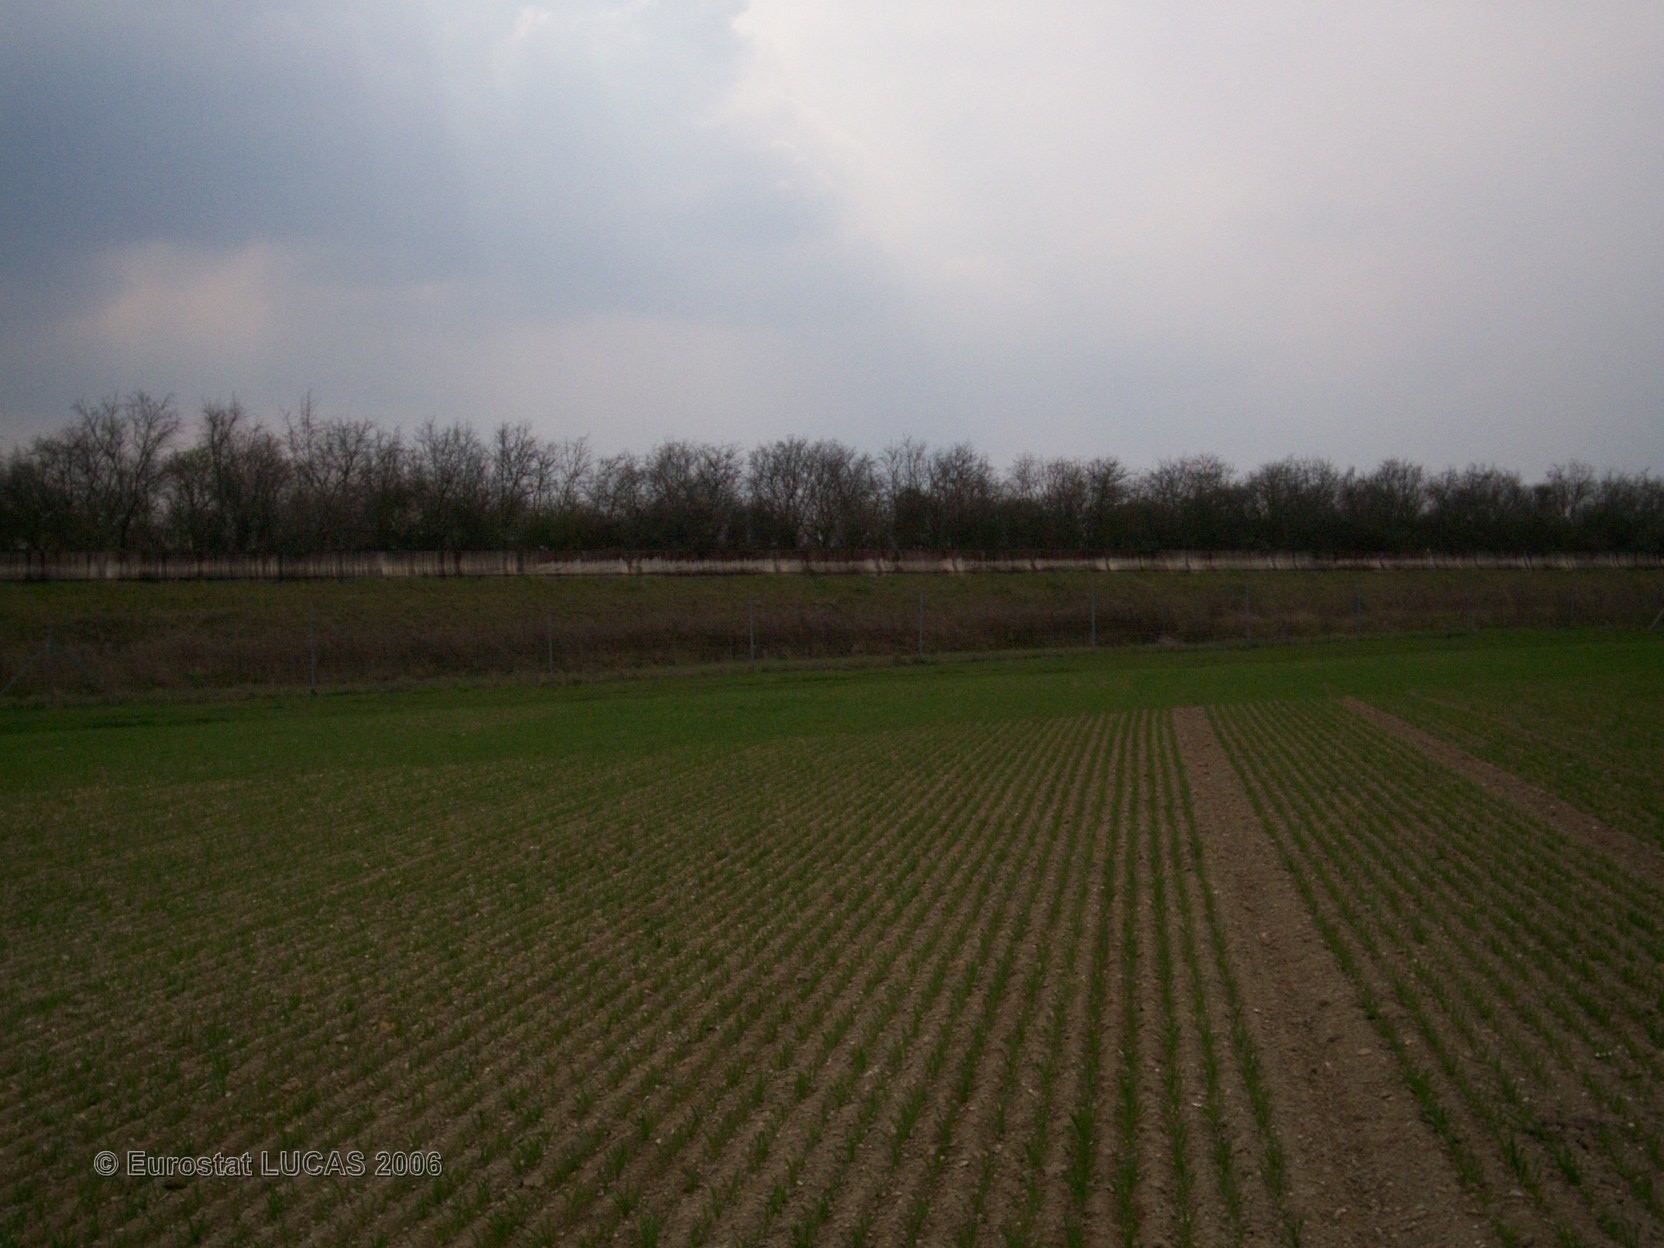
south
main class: Cropland
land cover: Barley
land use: Agriculture (excluding fallow land and kitchen gardens)
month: April
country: FR
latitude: 48.2408
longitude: 4.0042
